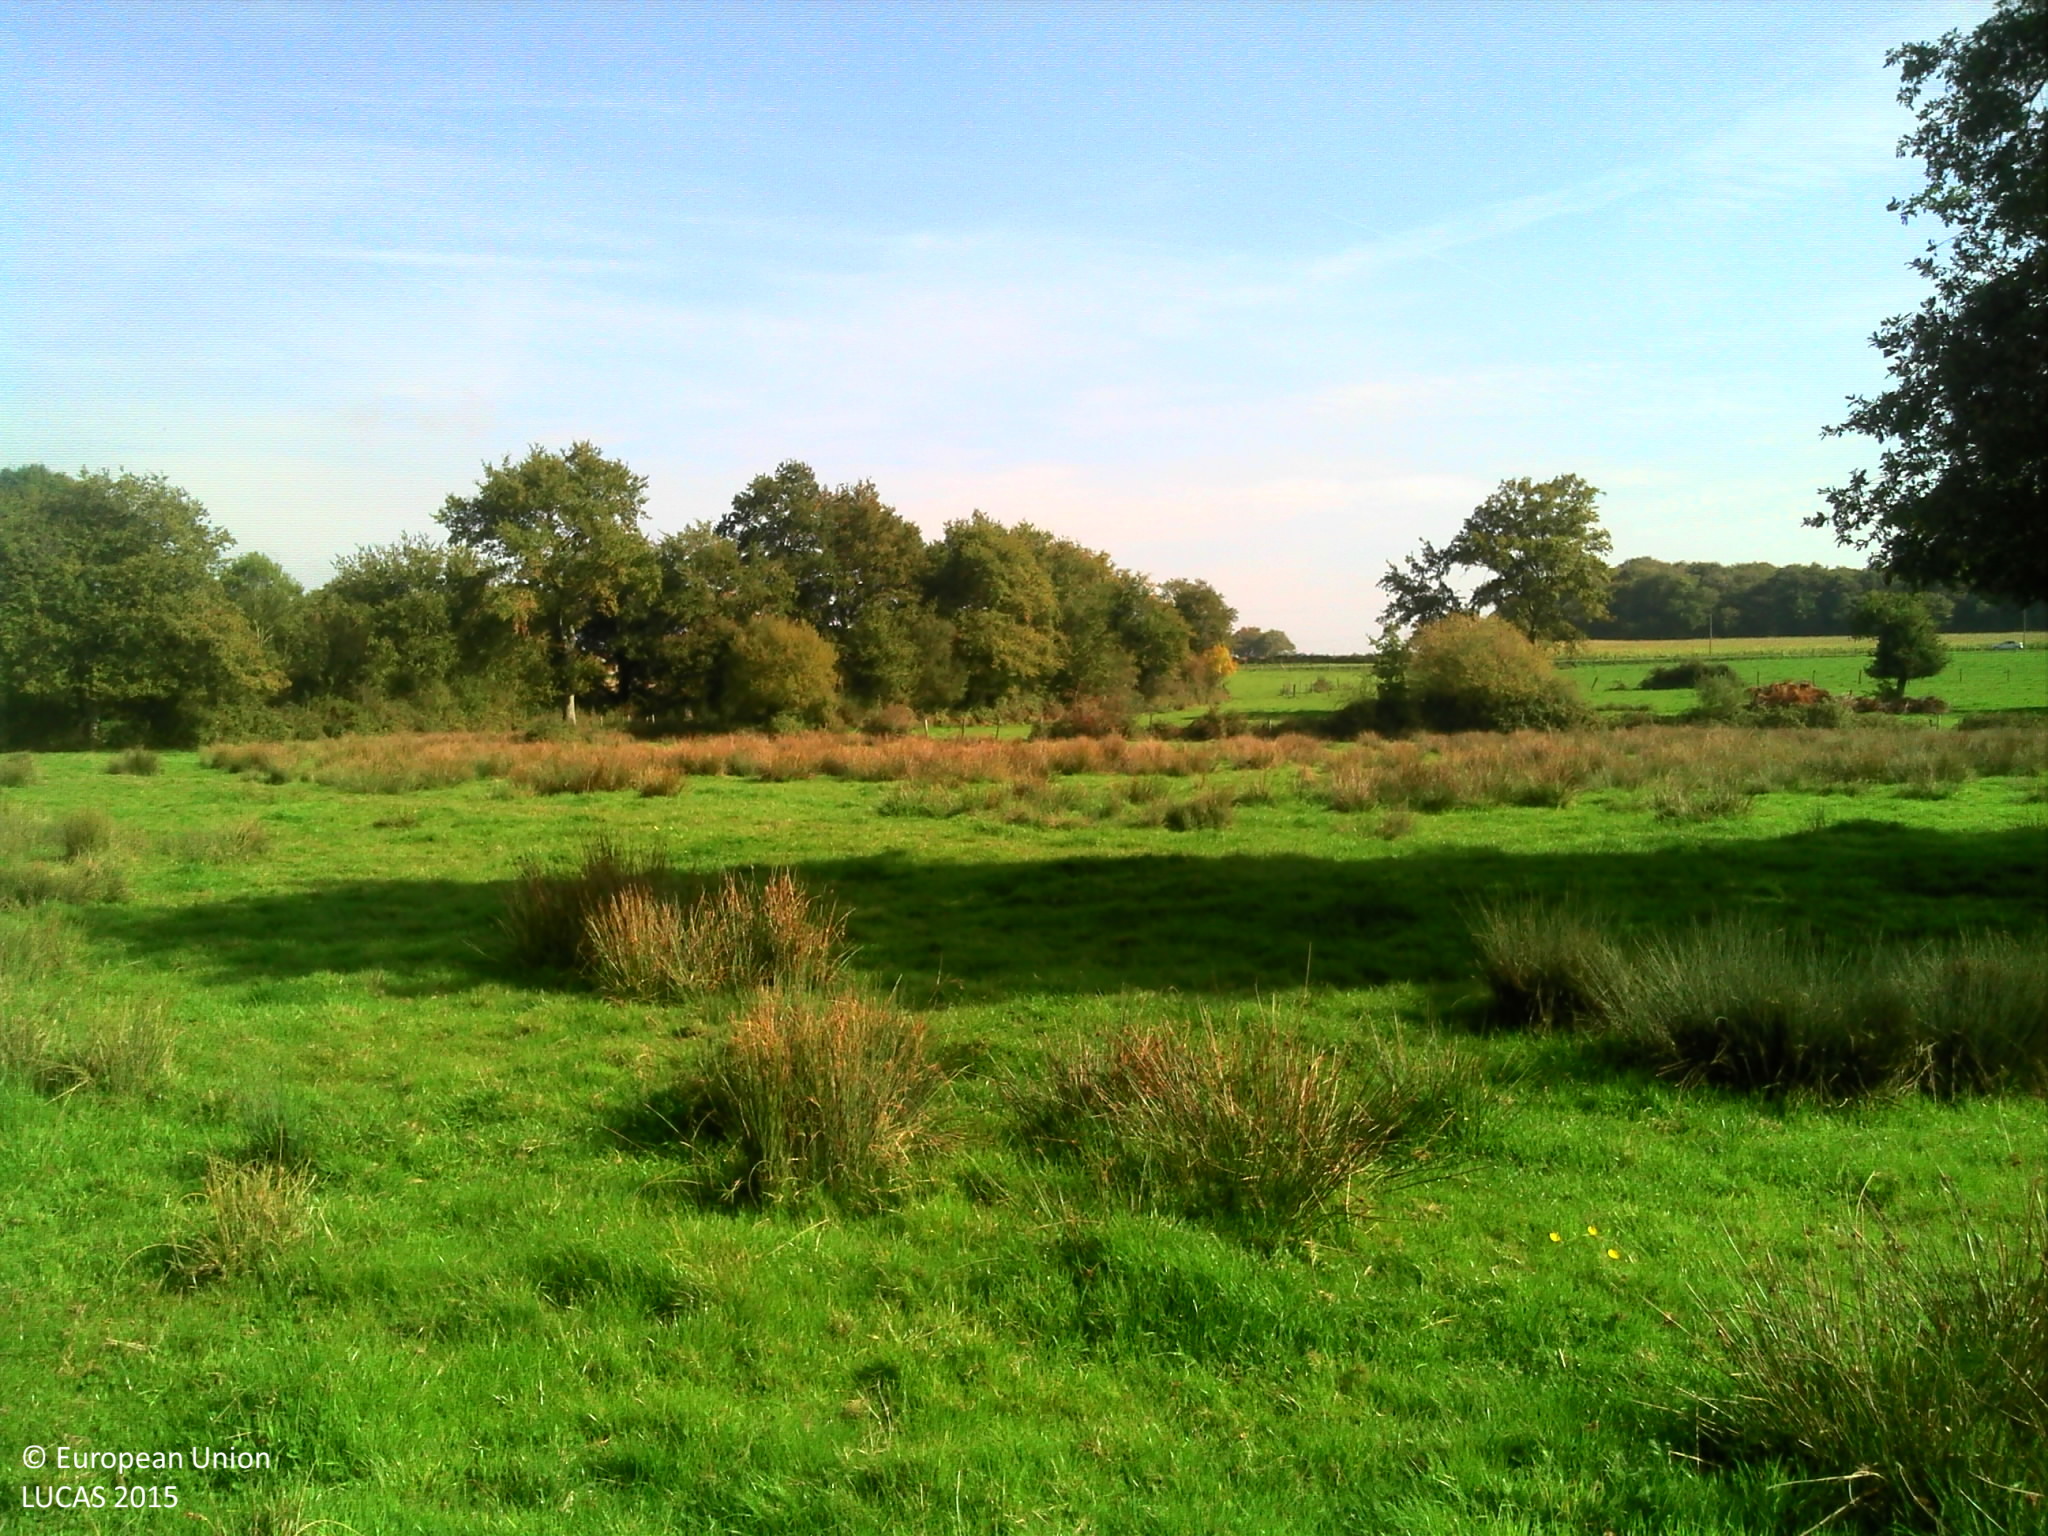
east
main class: Grassland
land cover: Grassland without tree/shrub cover
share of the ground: > 75 %
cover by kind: herbaceous plants 100 %
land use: Agriculture (excluding fallow land and kitchen gardens)
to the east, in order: Grassland without tree/shrub cover; Abandoned hedges; Fences; Rivers and streams; Grassland without tree/shrub cover; Fences; Abandoned hedges; Tracks; Abandoned hedges; Grassland without tree/shrub cover
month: October
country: FR
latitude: 47.0973
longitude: -0.9297
